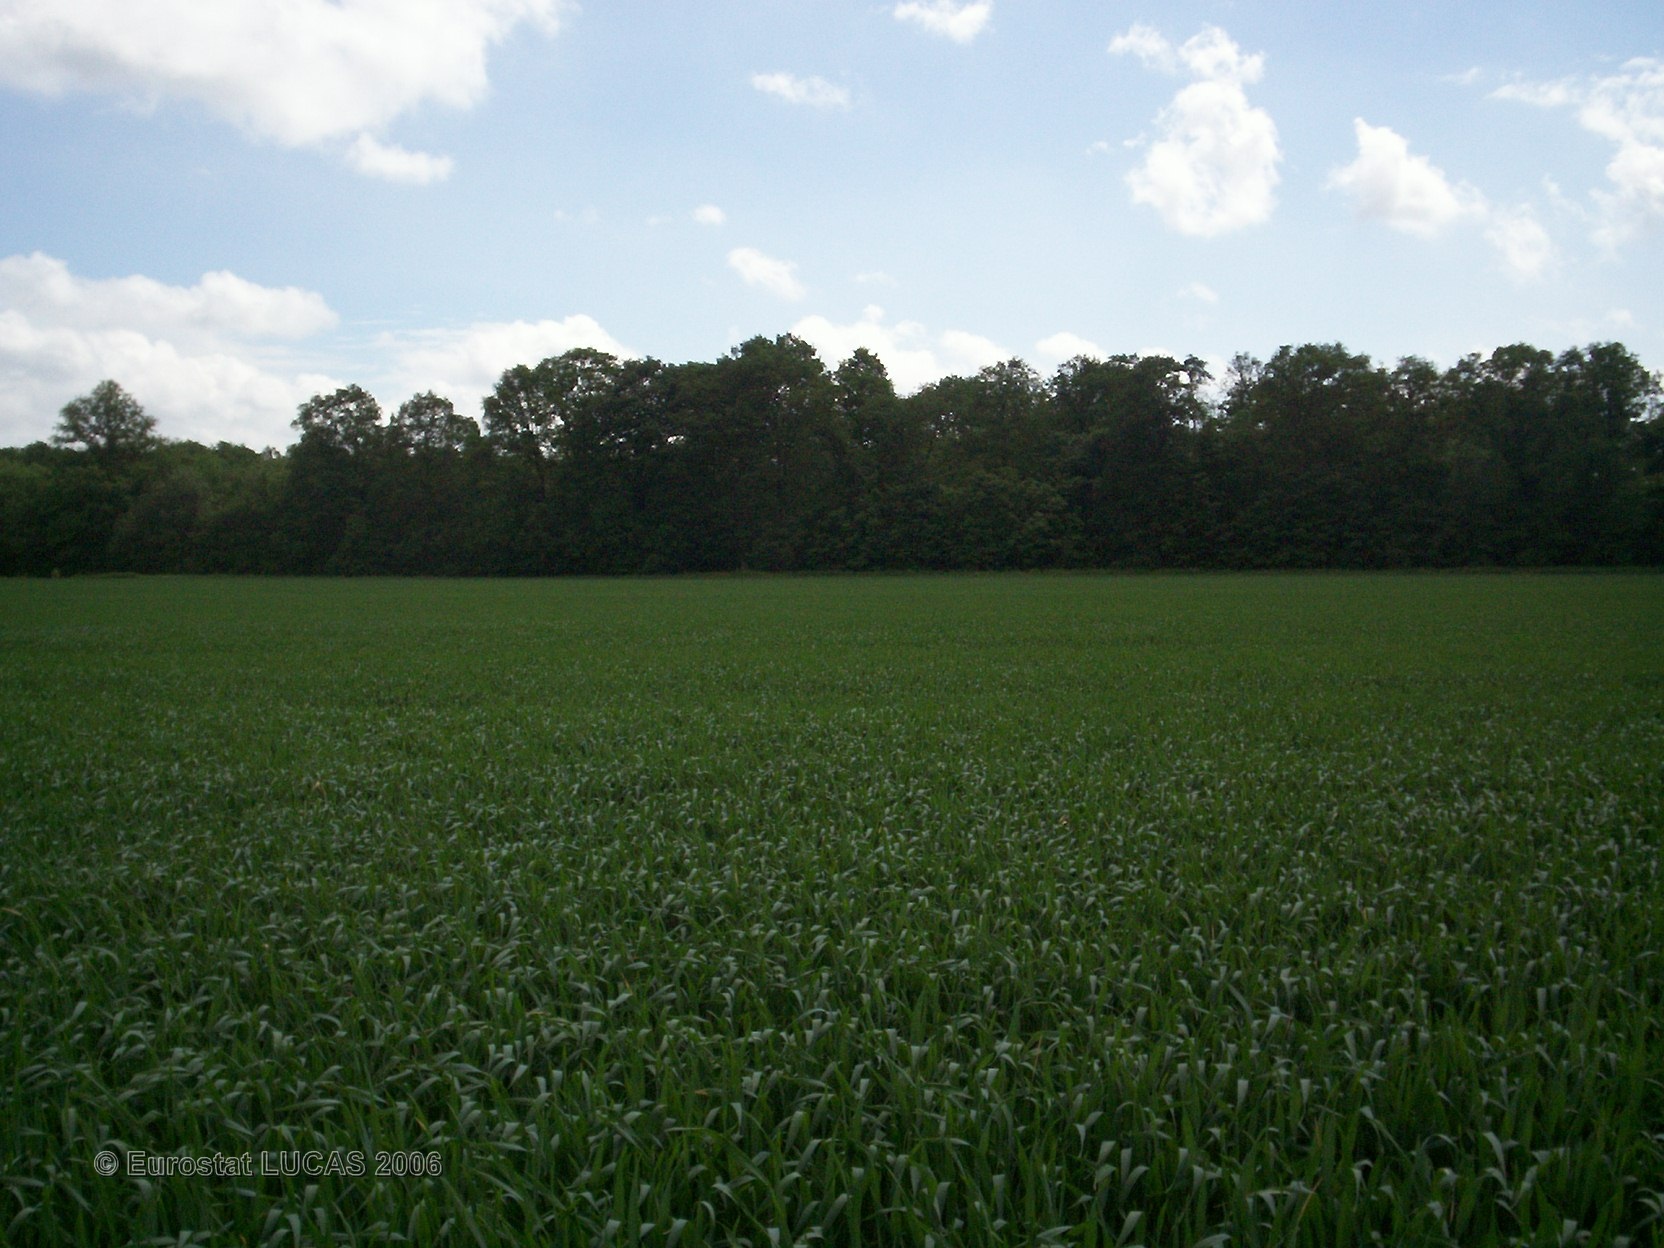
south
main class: Cropland
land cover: Common wheat
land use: Agriculture (excluding fallow land and kitchen gardens)
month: May
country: FR
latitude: 48.7267
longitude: 2.7717
